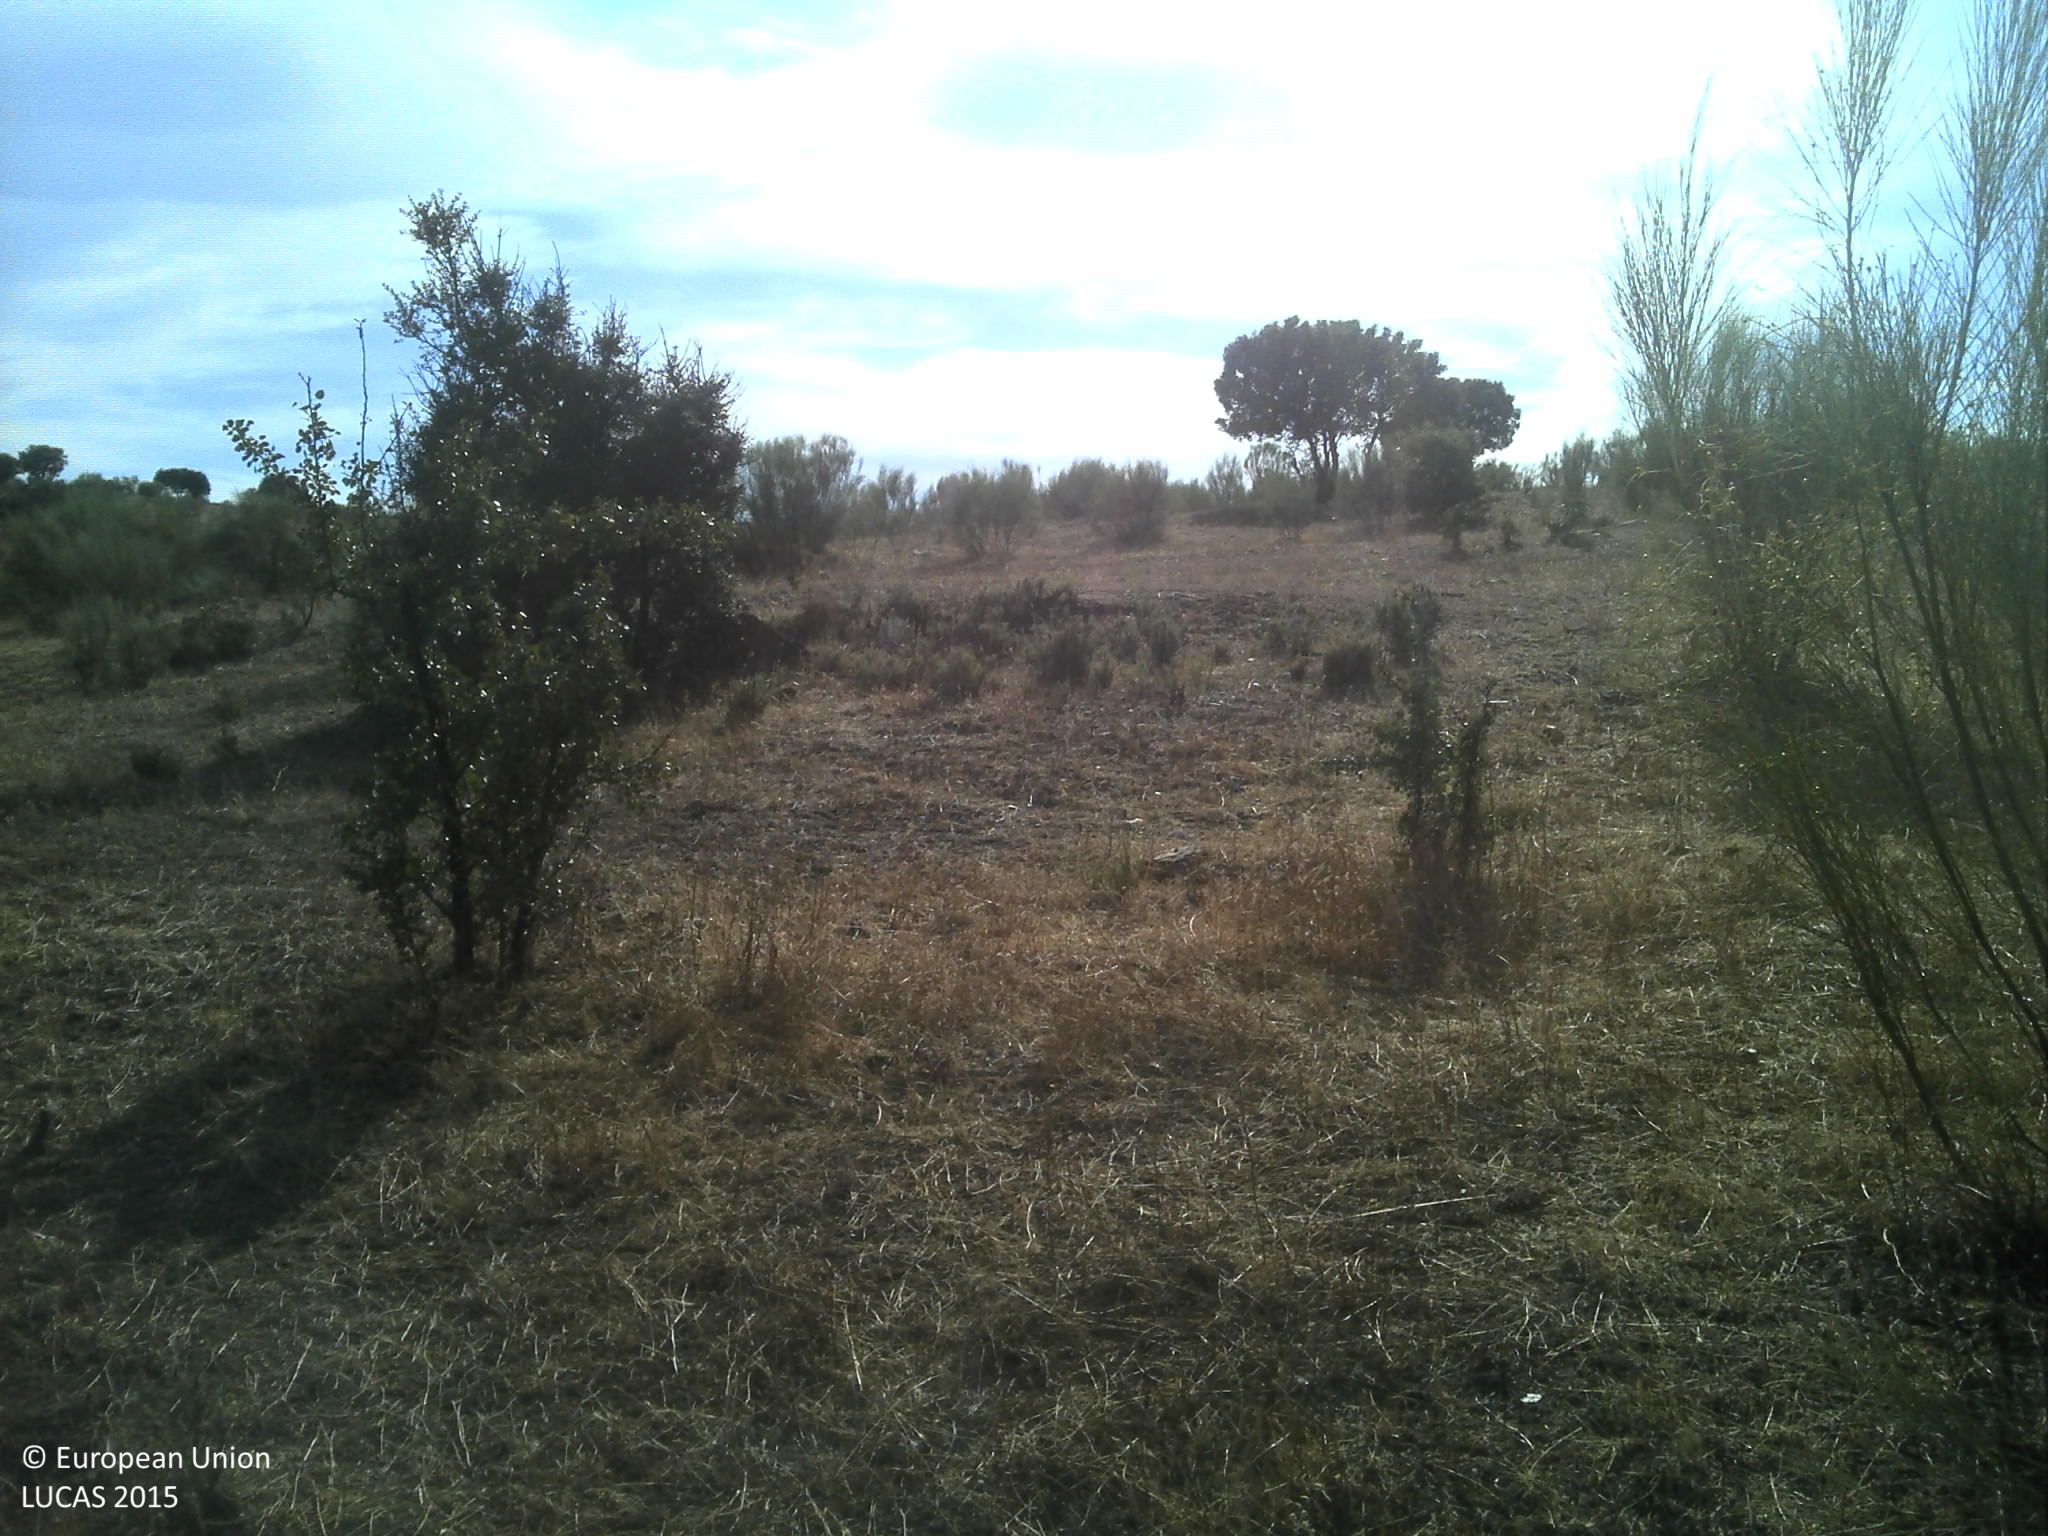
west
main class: Woodland
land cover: Broadleaved woodland
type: broadleaved evergreen forest
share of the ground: 10 - 25 %
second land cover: Grassland without tree/shrub cover
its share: 25 - 50 %
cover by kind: unconsolidated bare surface 45 %, herbaceous plants 30 %, broadleaved forest trees 15 %, shrubs 10 %
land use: Forestry
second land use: Agriculture (excluding fallow land and kitchen gardens)
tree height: > 5 m
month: June
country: PT
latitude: 39.8670
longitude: -6.9568
